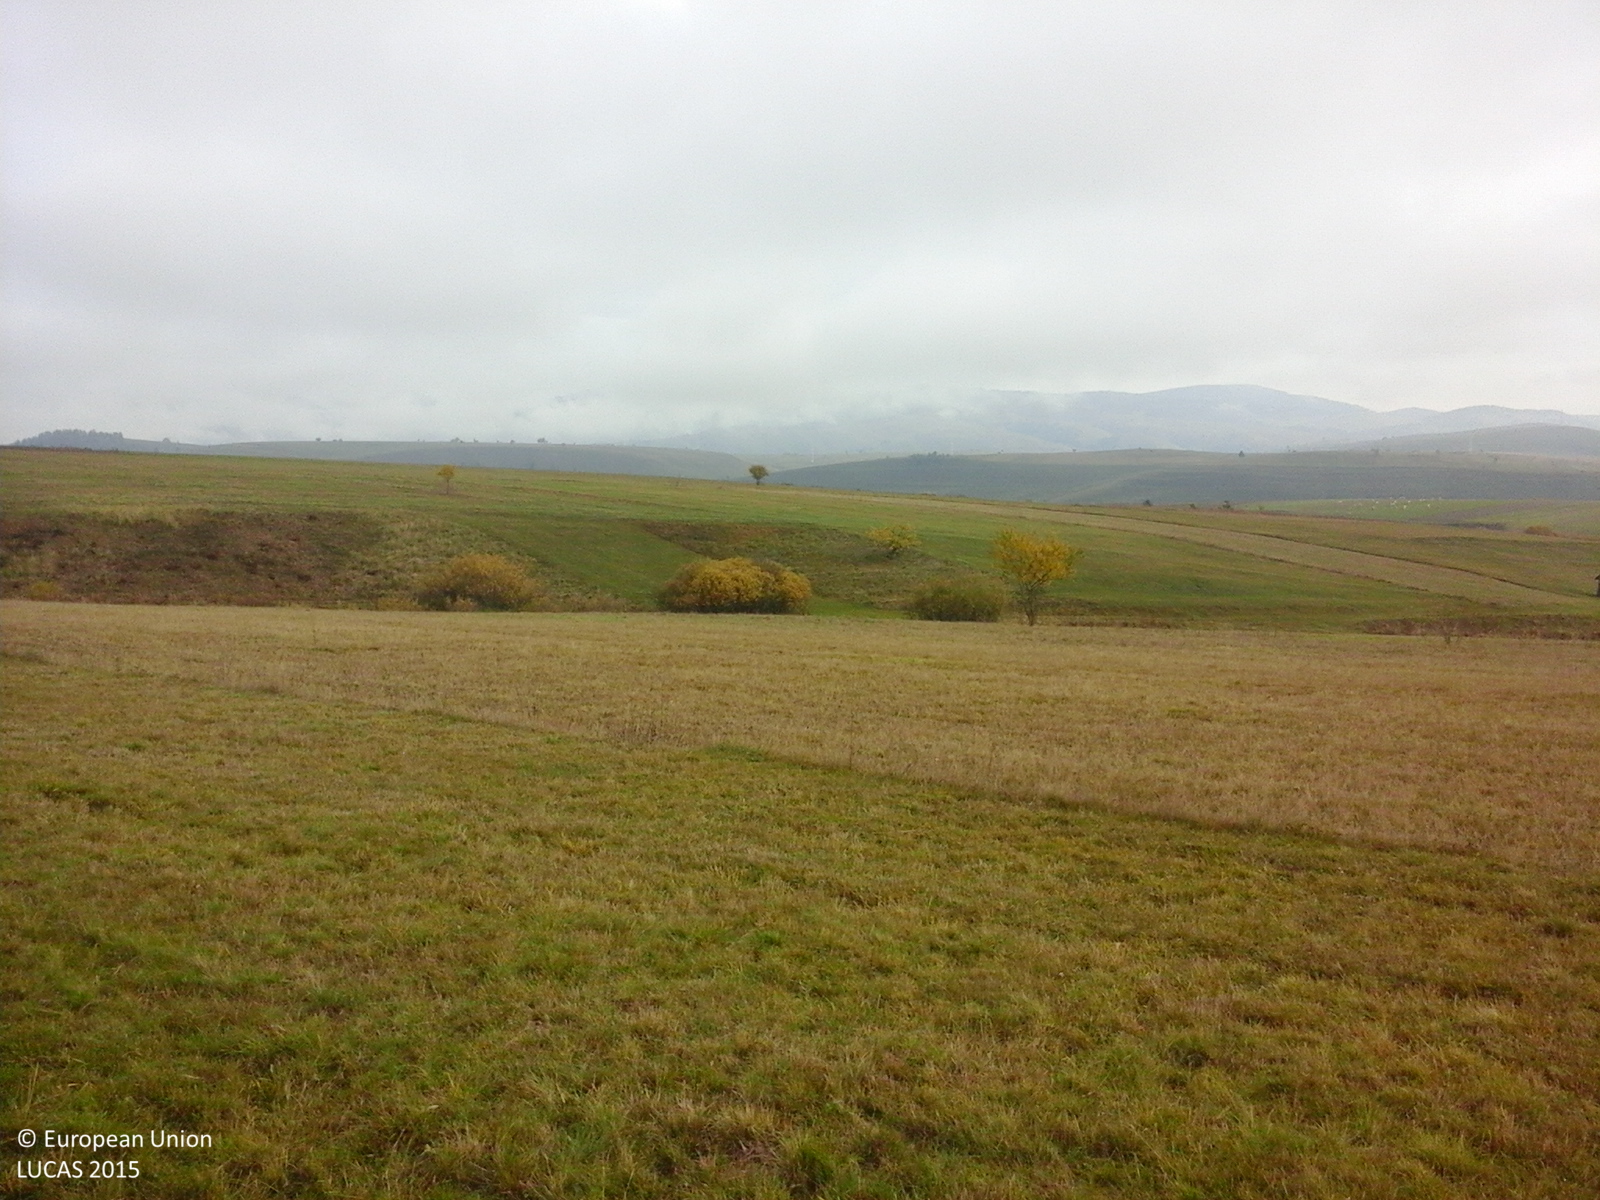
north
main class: Grassland
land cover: Grassland without tree/shrub cover
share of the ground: > 75 %
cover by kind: herbaceous plants 100 %
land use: Agriculture (excluding fallow land and kitchen gardens)
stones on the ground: < 10 %
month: October
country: RO
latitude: 46.8346
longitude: 25.4364
